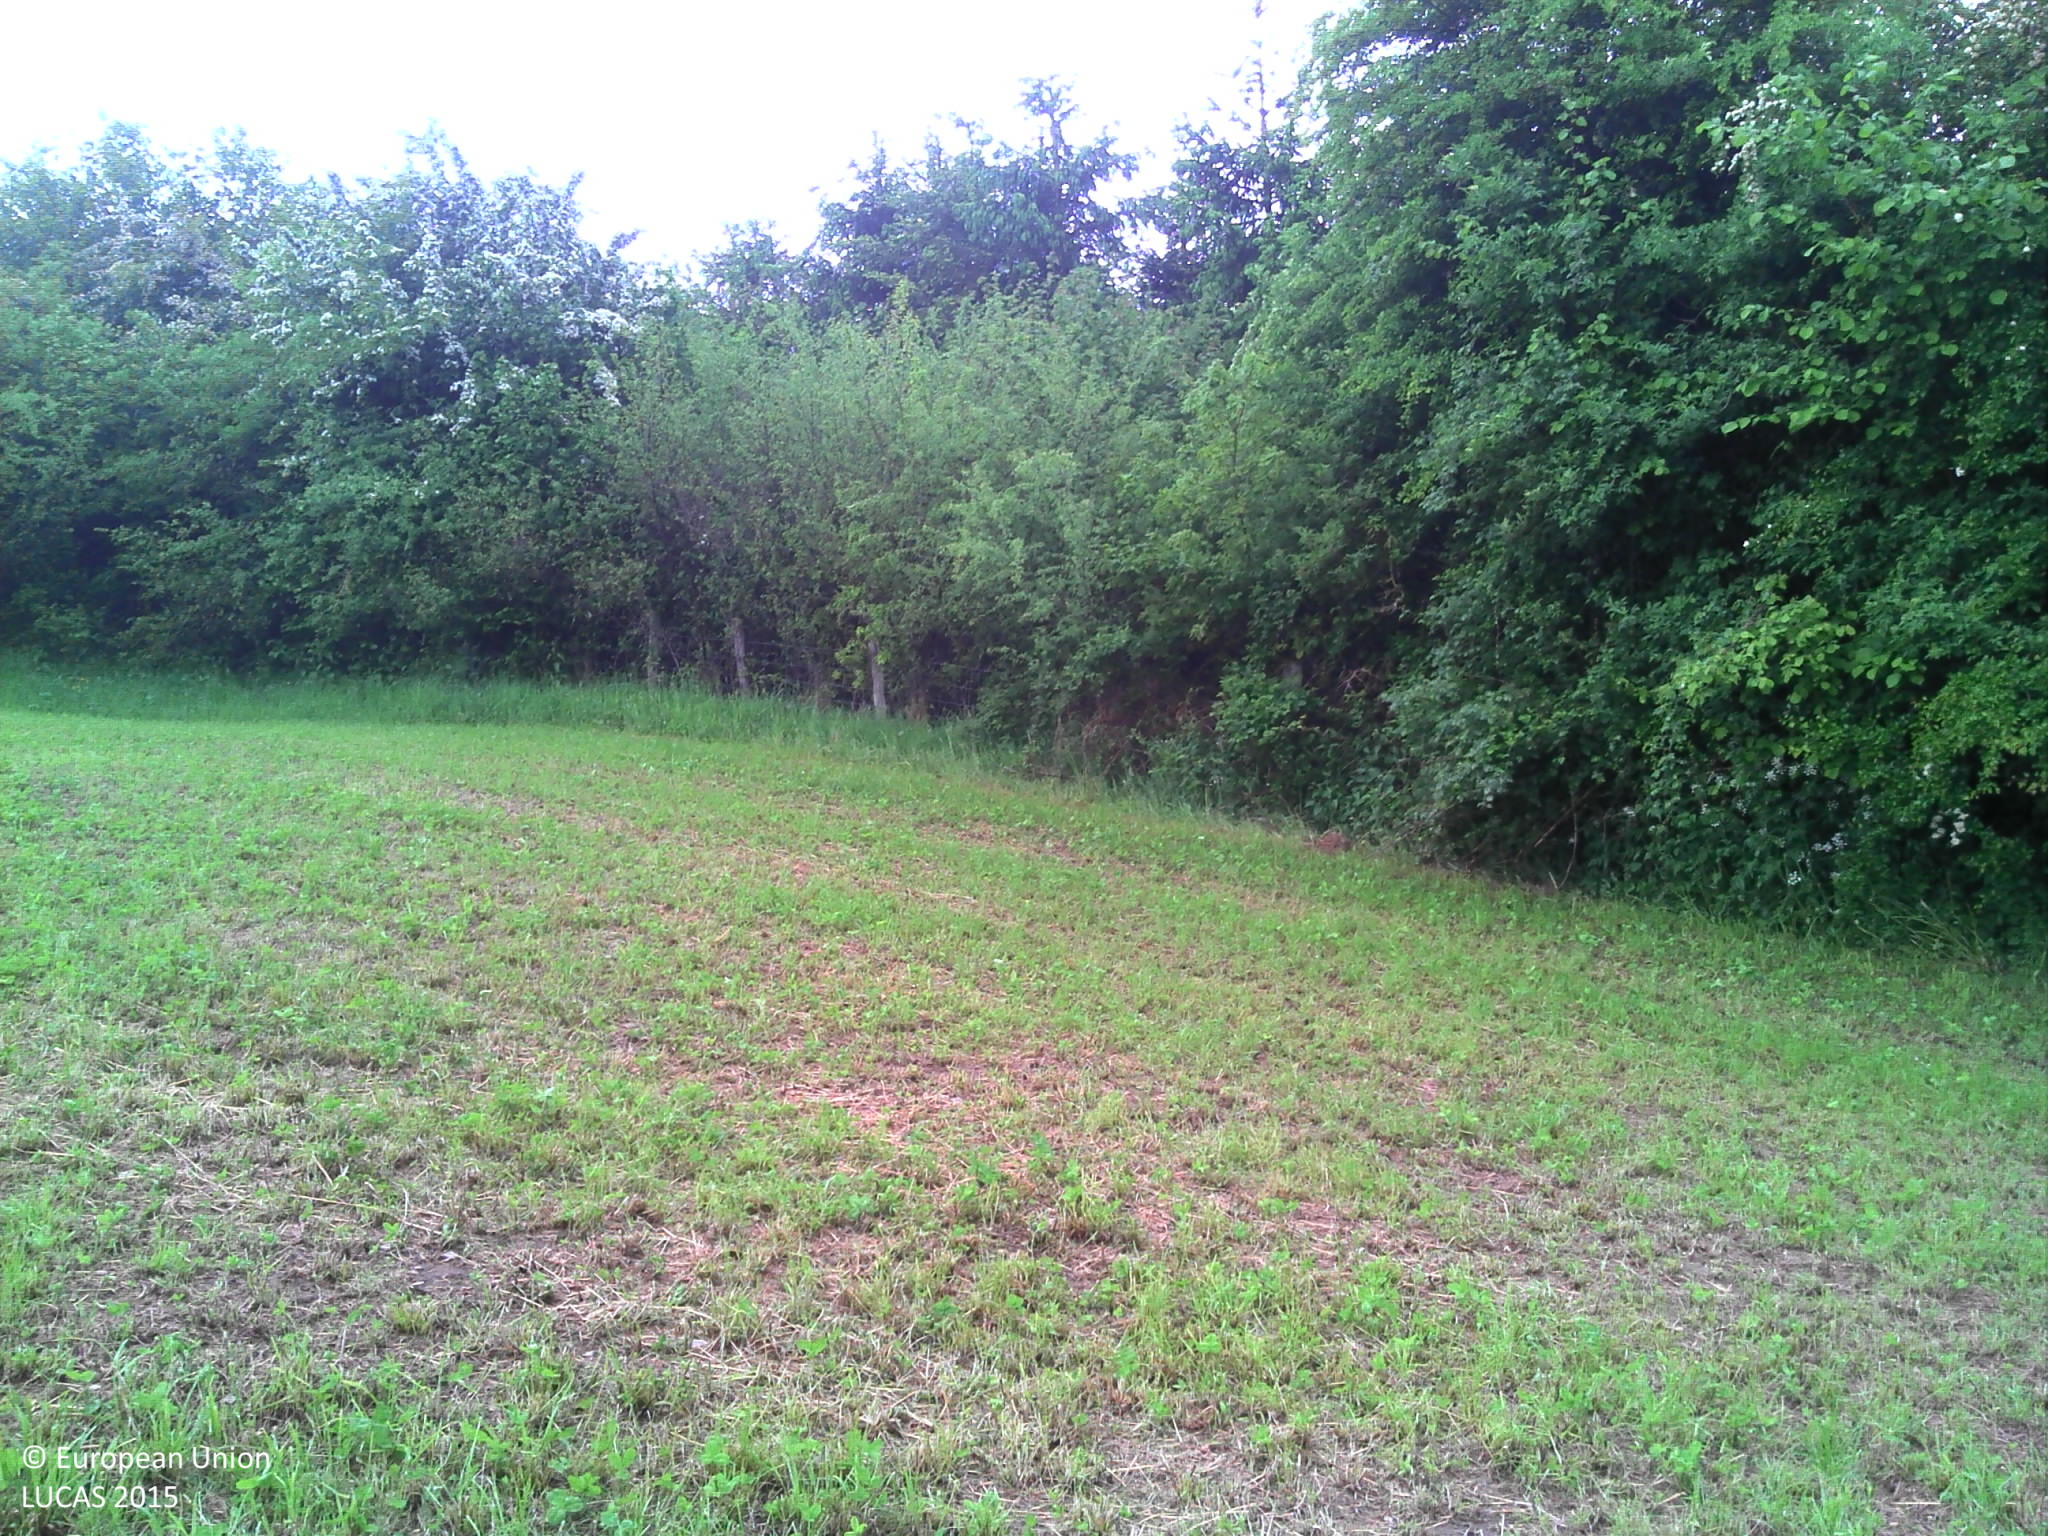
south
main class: Grassland
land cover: Grassland without tree/shrub cover
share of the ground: > 75 %
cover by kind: herbaceous plants 100 %
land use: Agriculture (excluding fallow land and kitchen gardens)
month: June
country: BE
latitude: 50.3219
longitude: 5.7710
